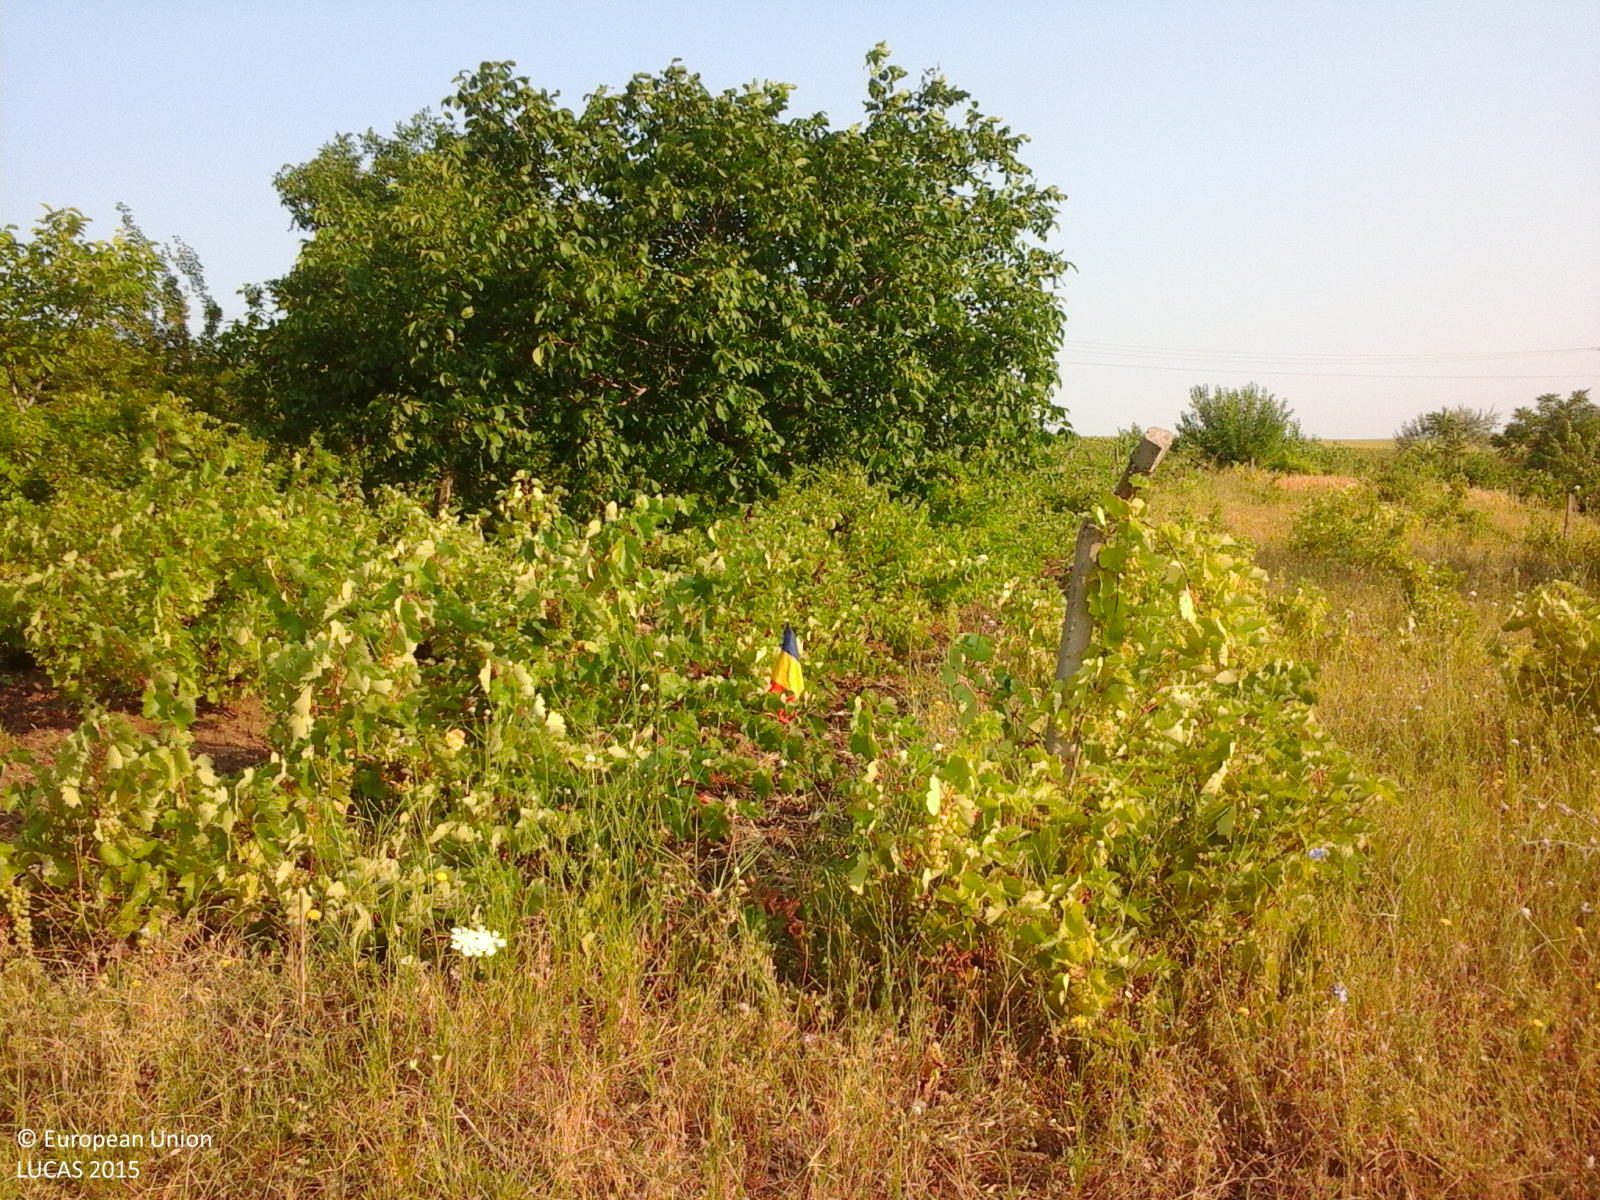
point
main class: Cropland
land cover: Vineyards
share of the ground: > 75 %
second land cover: Grassland without tree/shrub cover
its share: > 75 %
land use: Agriculture (excluding fallow land and kitchen gardens)
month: July
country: RO
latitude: 45.8476
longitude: 27.7415
